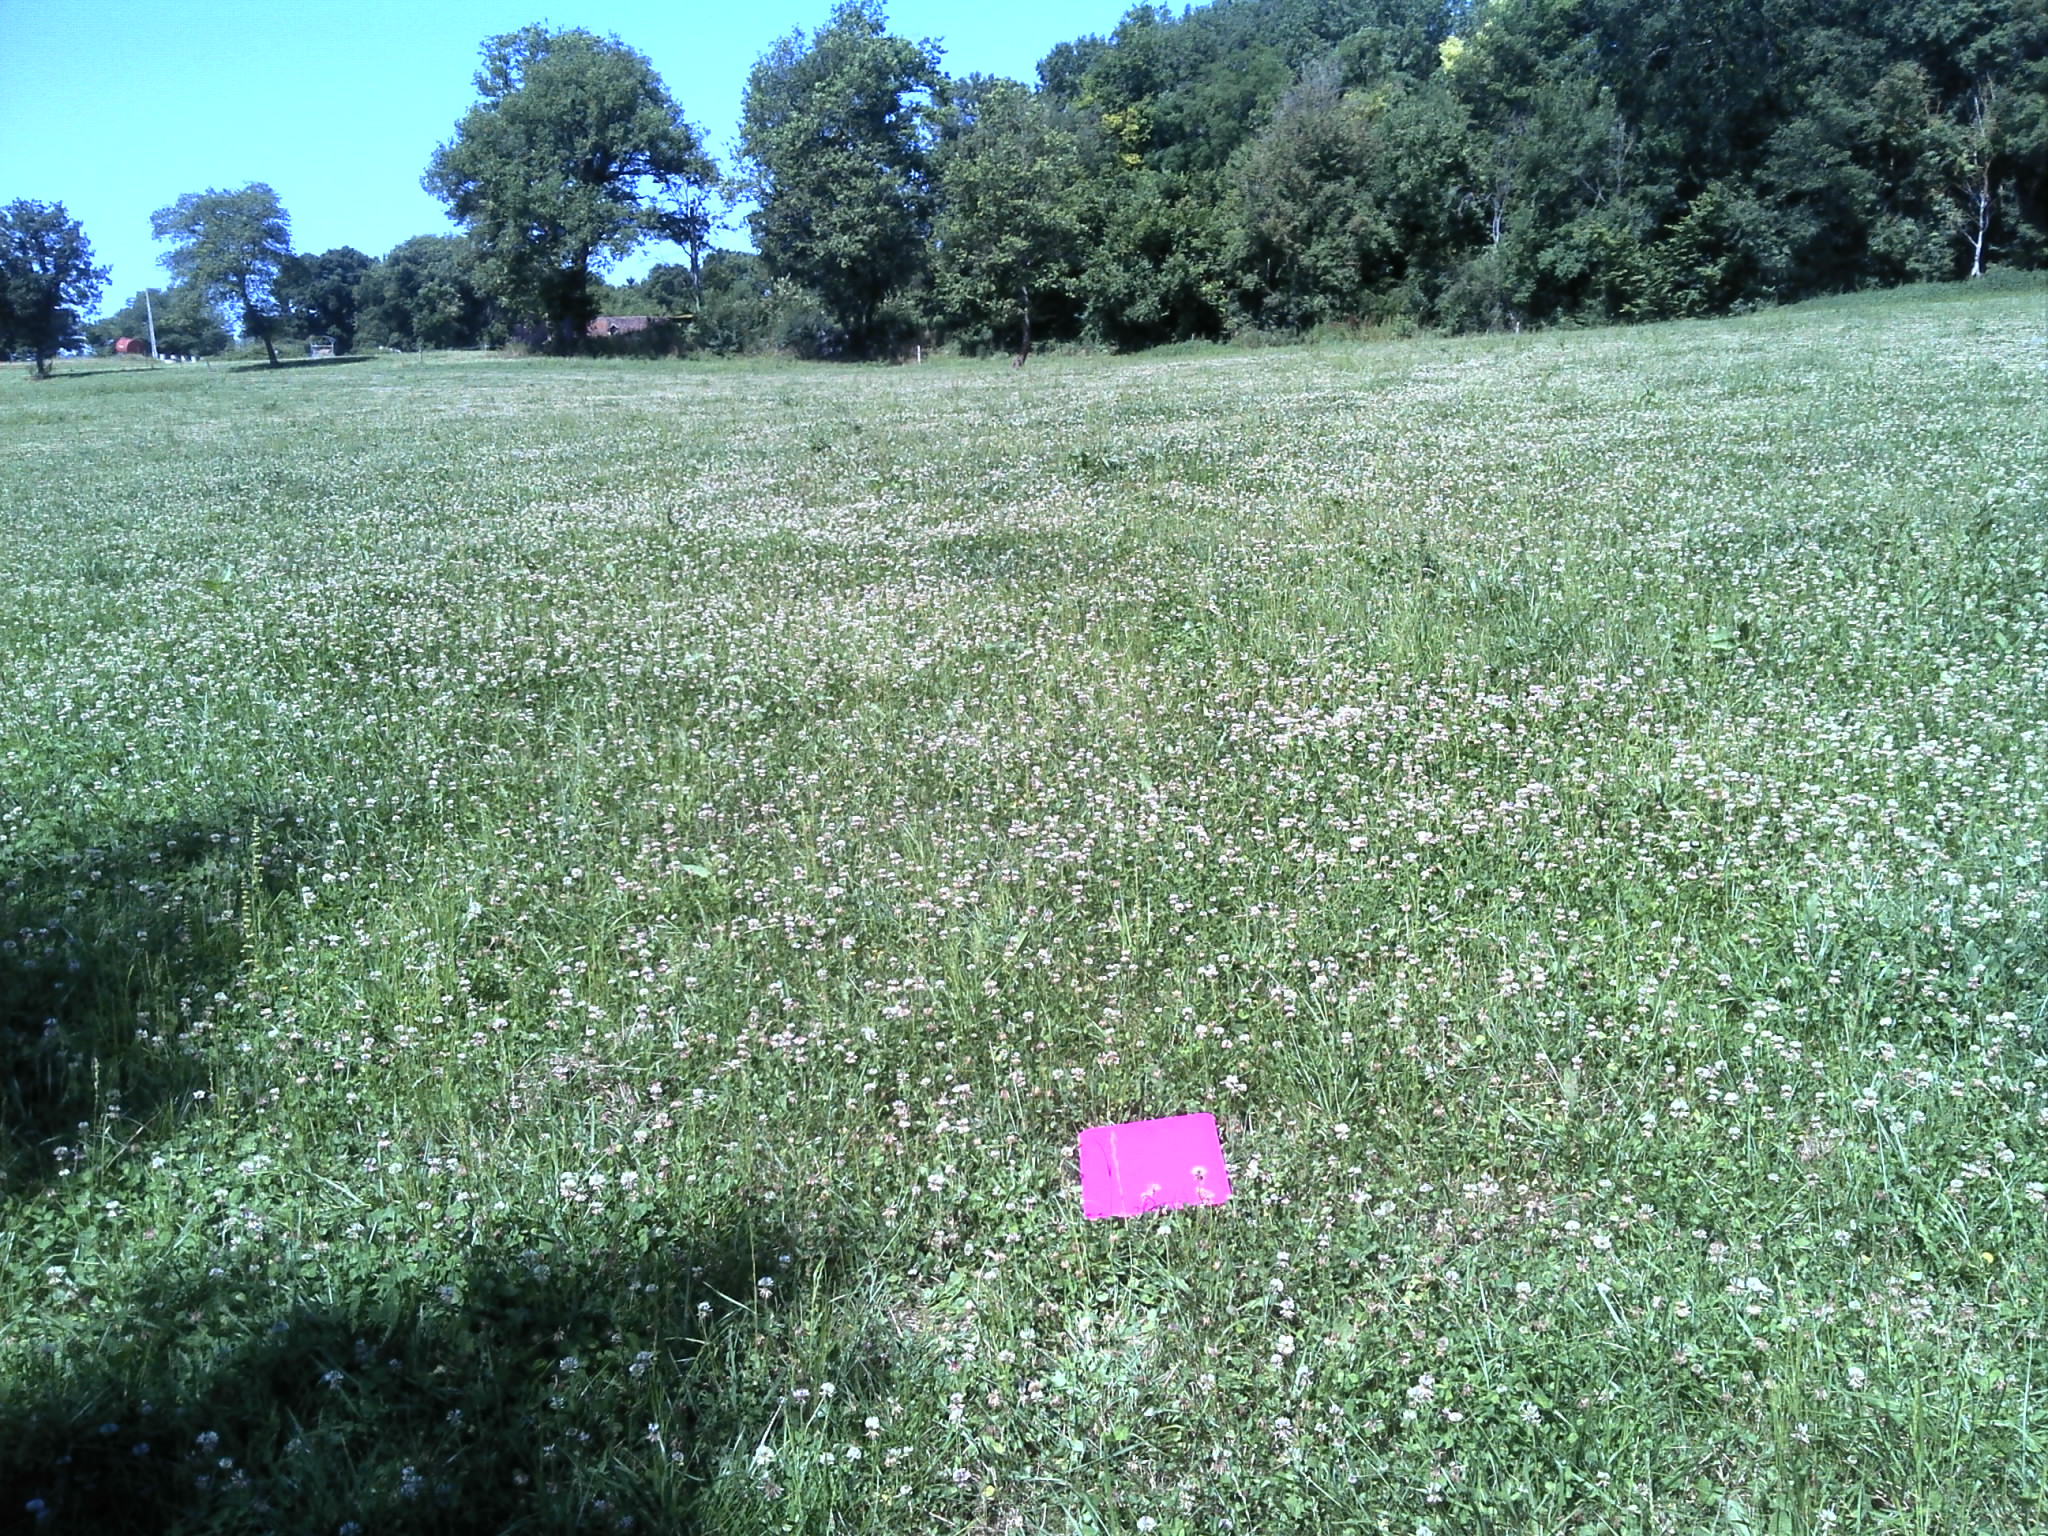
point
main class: Cropland
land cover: Clovers
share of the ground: > 75 %
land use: Agriculture (excluding fallow land and kitchen gardens)
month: June
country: FR
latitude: 46.6532
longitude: 1.1404
